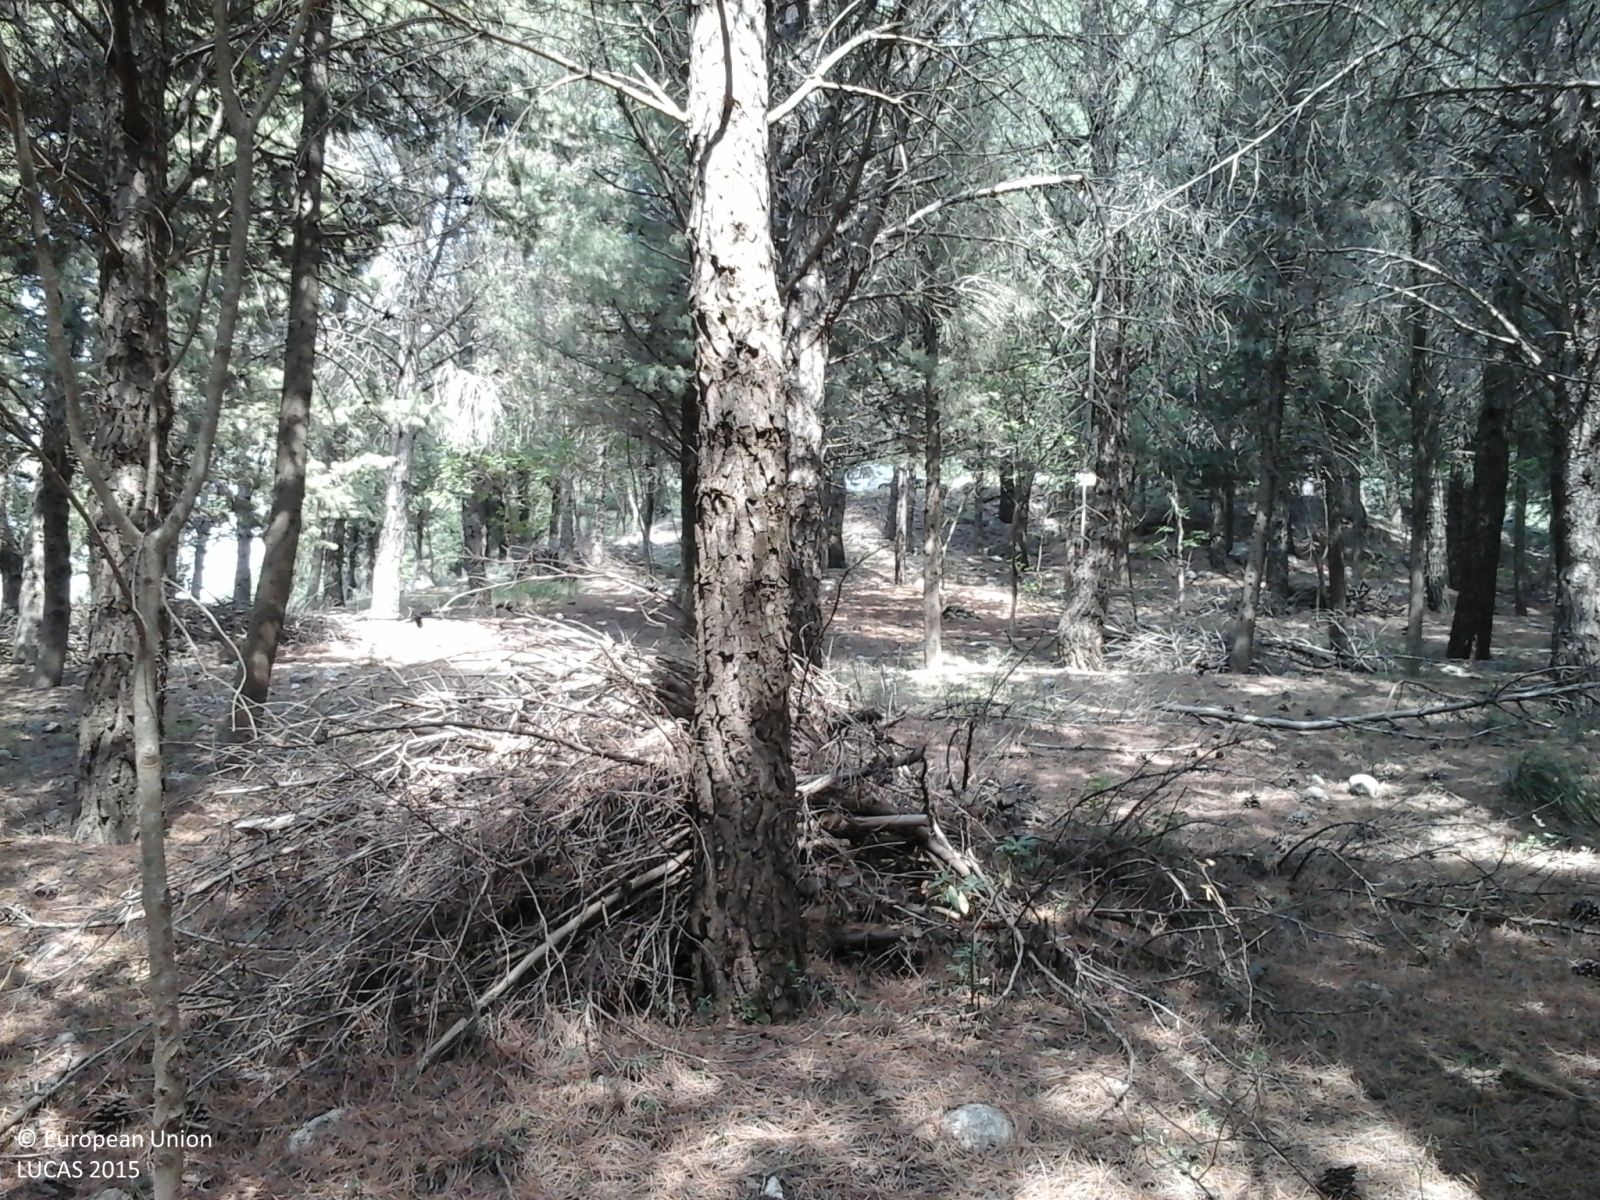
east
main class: Woodland
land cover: Pine dominated coniferous woodland
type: coniferous forest of the mediterranean region
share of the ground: > 75 %
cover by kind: coniferous forest trees 90 %, consolidated bare surface 10 %
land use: Forestry
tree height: > 5 m
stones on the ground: < 10 %
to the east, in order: Pine dominated coniferous woodland; Tracks; Pine dominated coniferous woodland
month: July
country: IT
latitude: 37.6106
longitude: 13.4969
